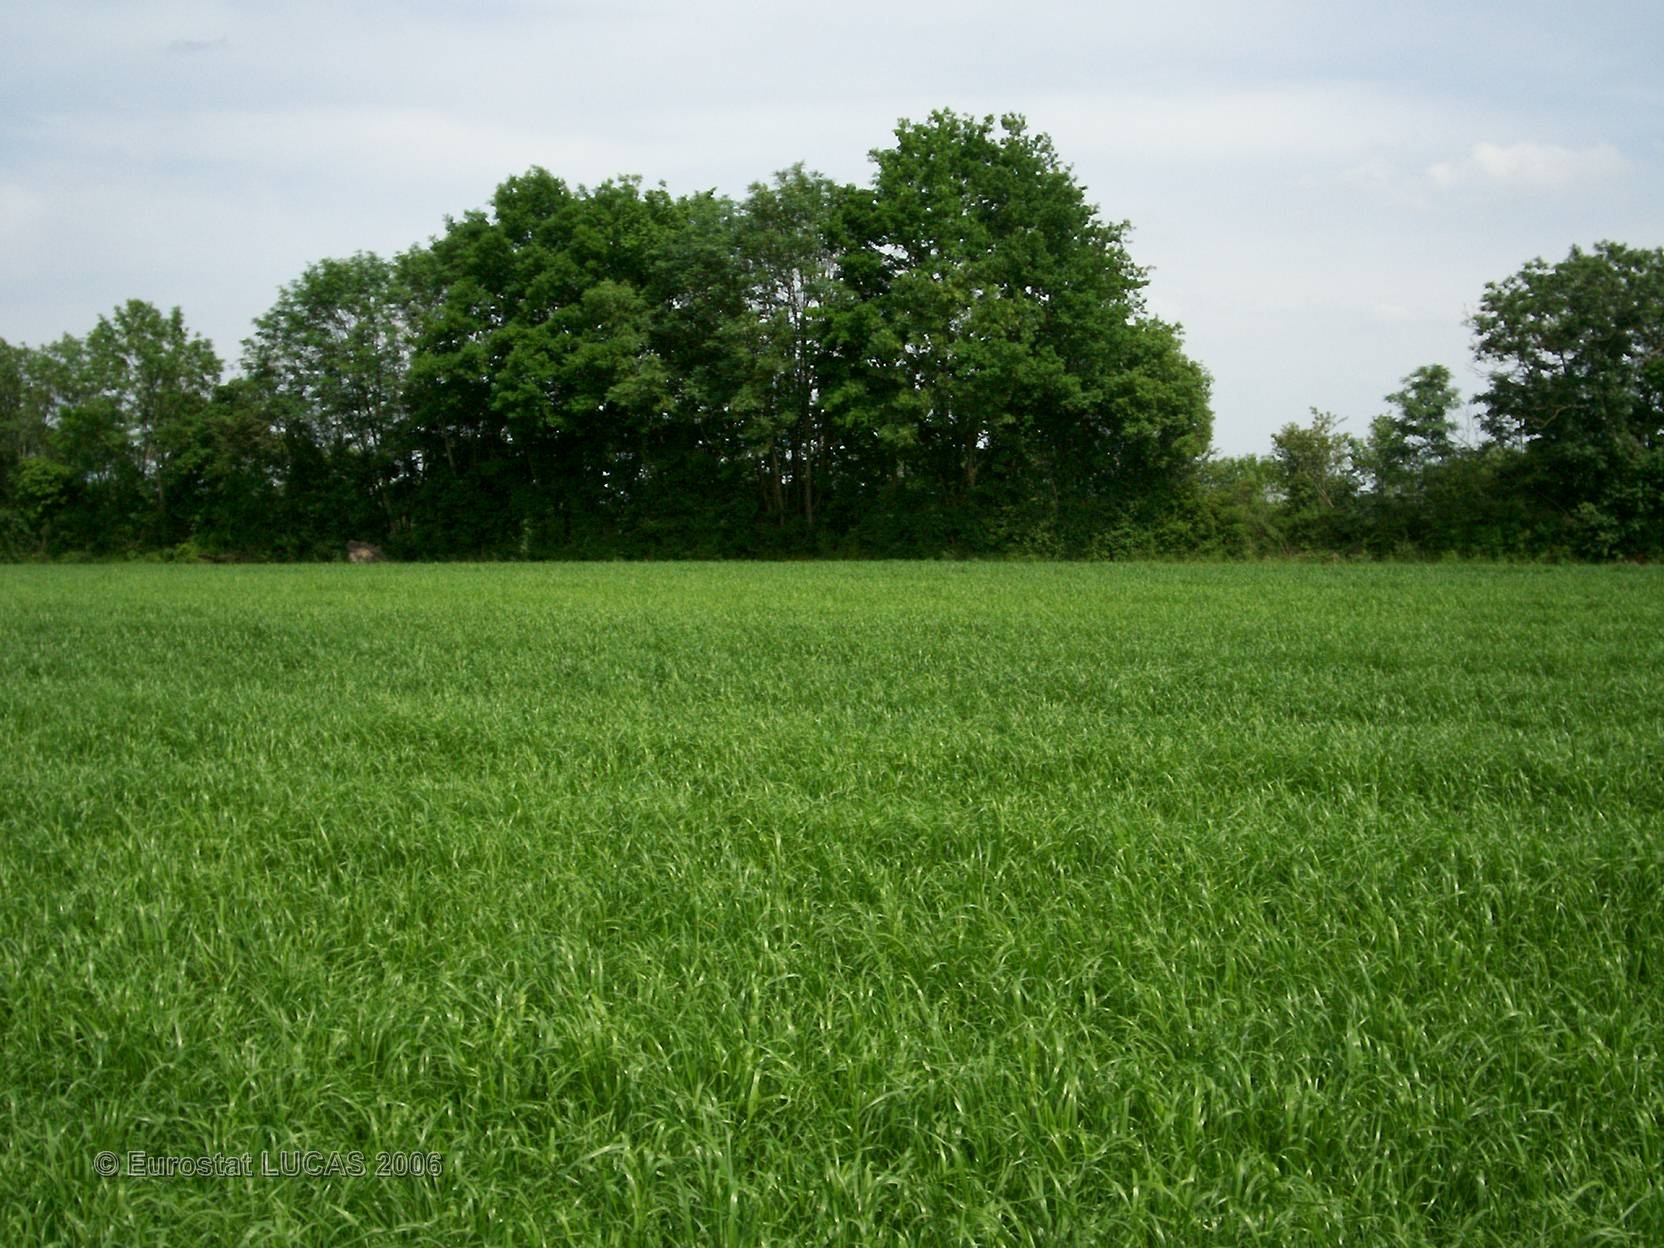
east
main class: Grassland
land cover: Grassland without tree/shrub cover
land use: Agriculture (excluding fallow land and kitchen gardens)
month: May
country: FR
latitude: 46.4520
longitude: -0.2961
